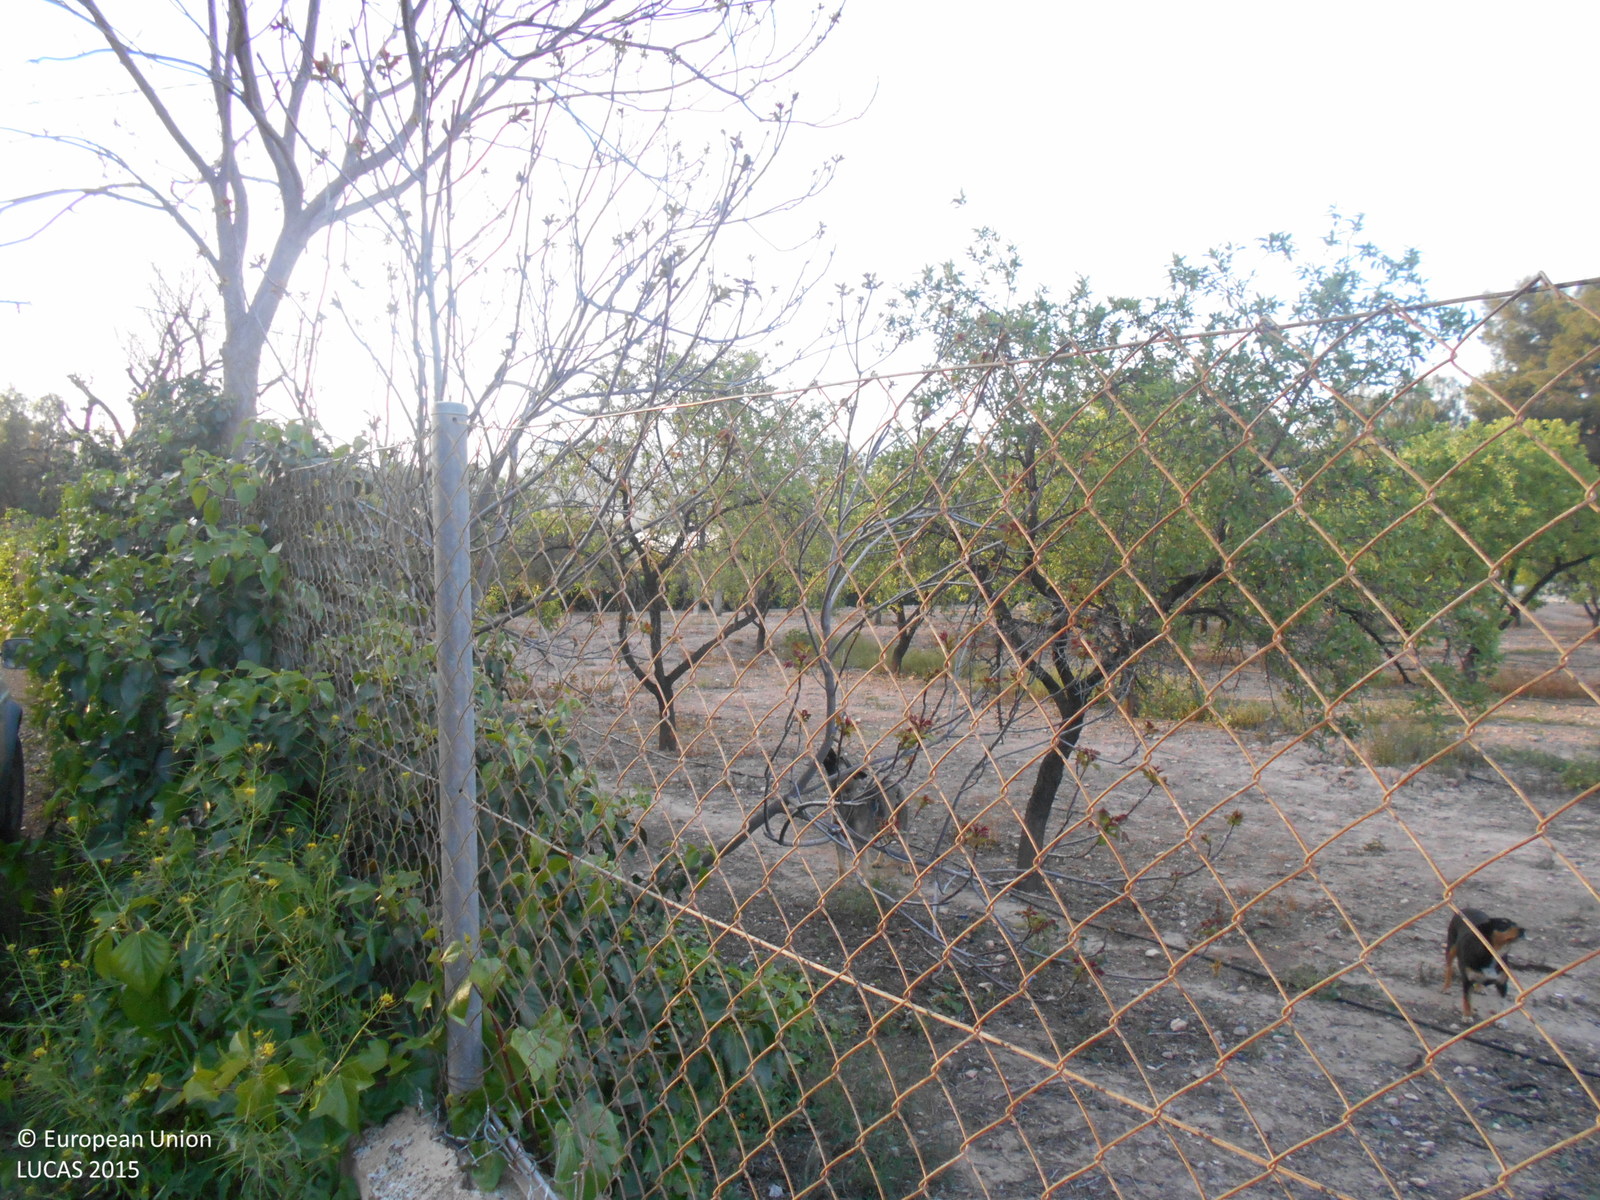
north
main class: Cropland
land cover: Nuts trees
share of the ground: 50 - 75 %
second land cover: Other bare soil
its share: > 75 %
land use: Agriculture (excluding fallow land and kitchen gardens)
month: April
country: ES
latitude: 37.7758
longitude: -1.5295
